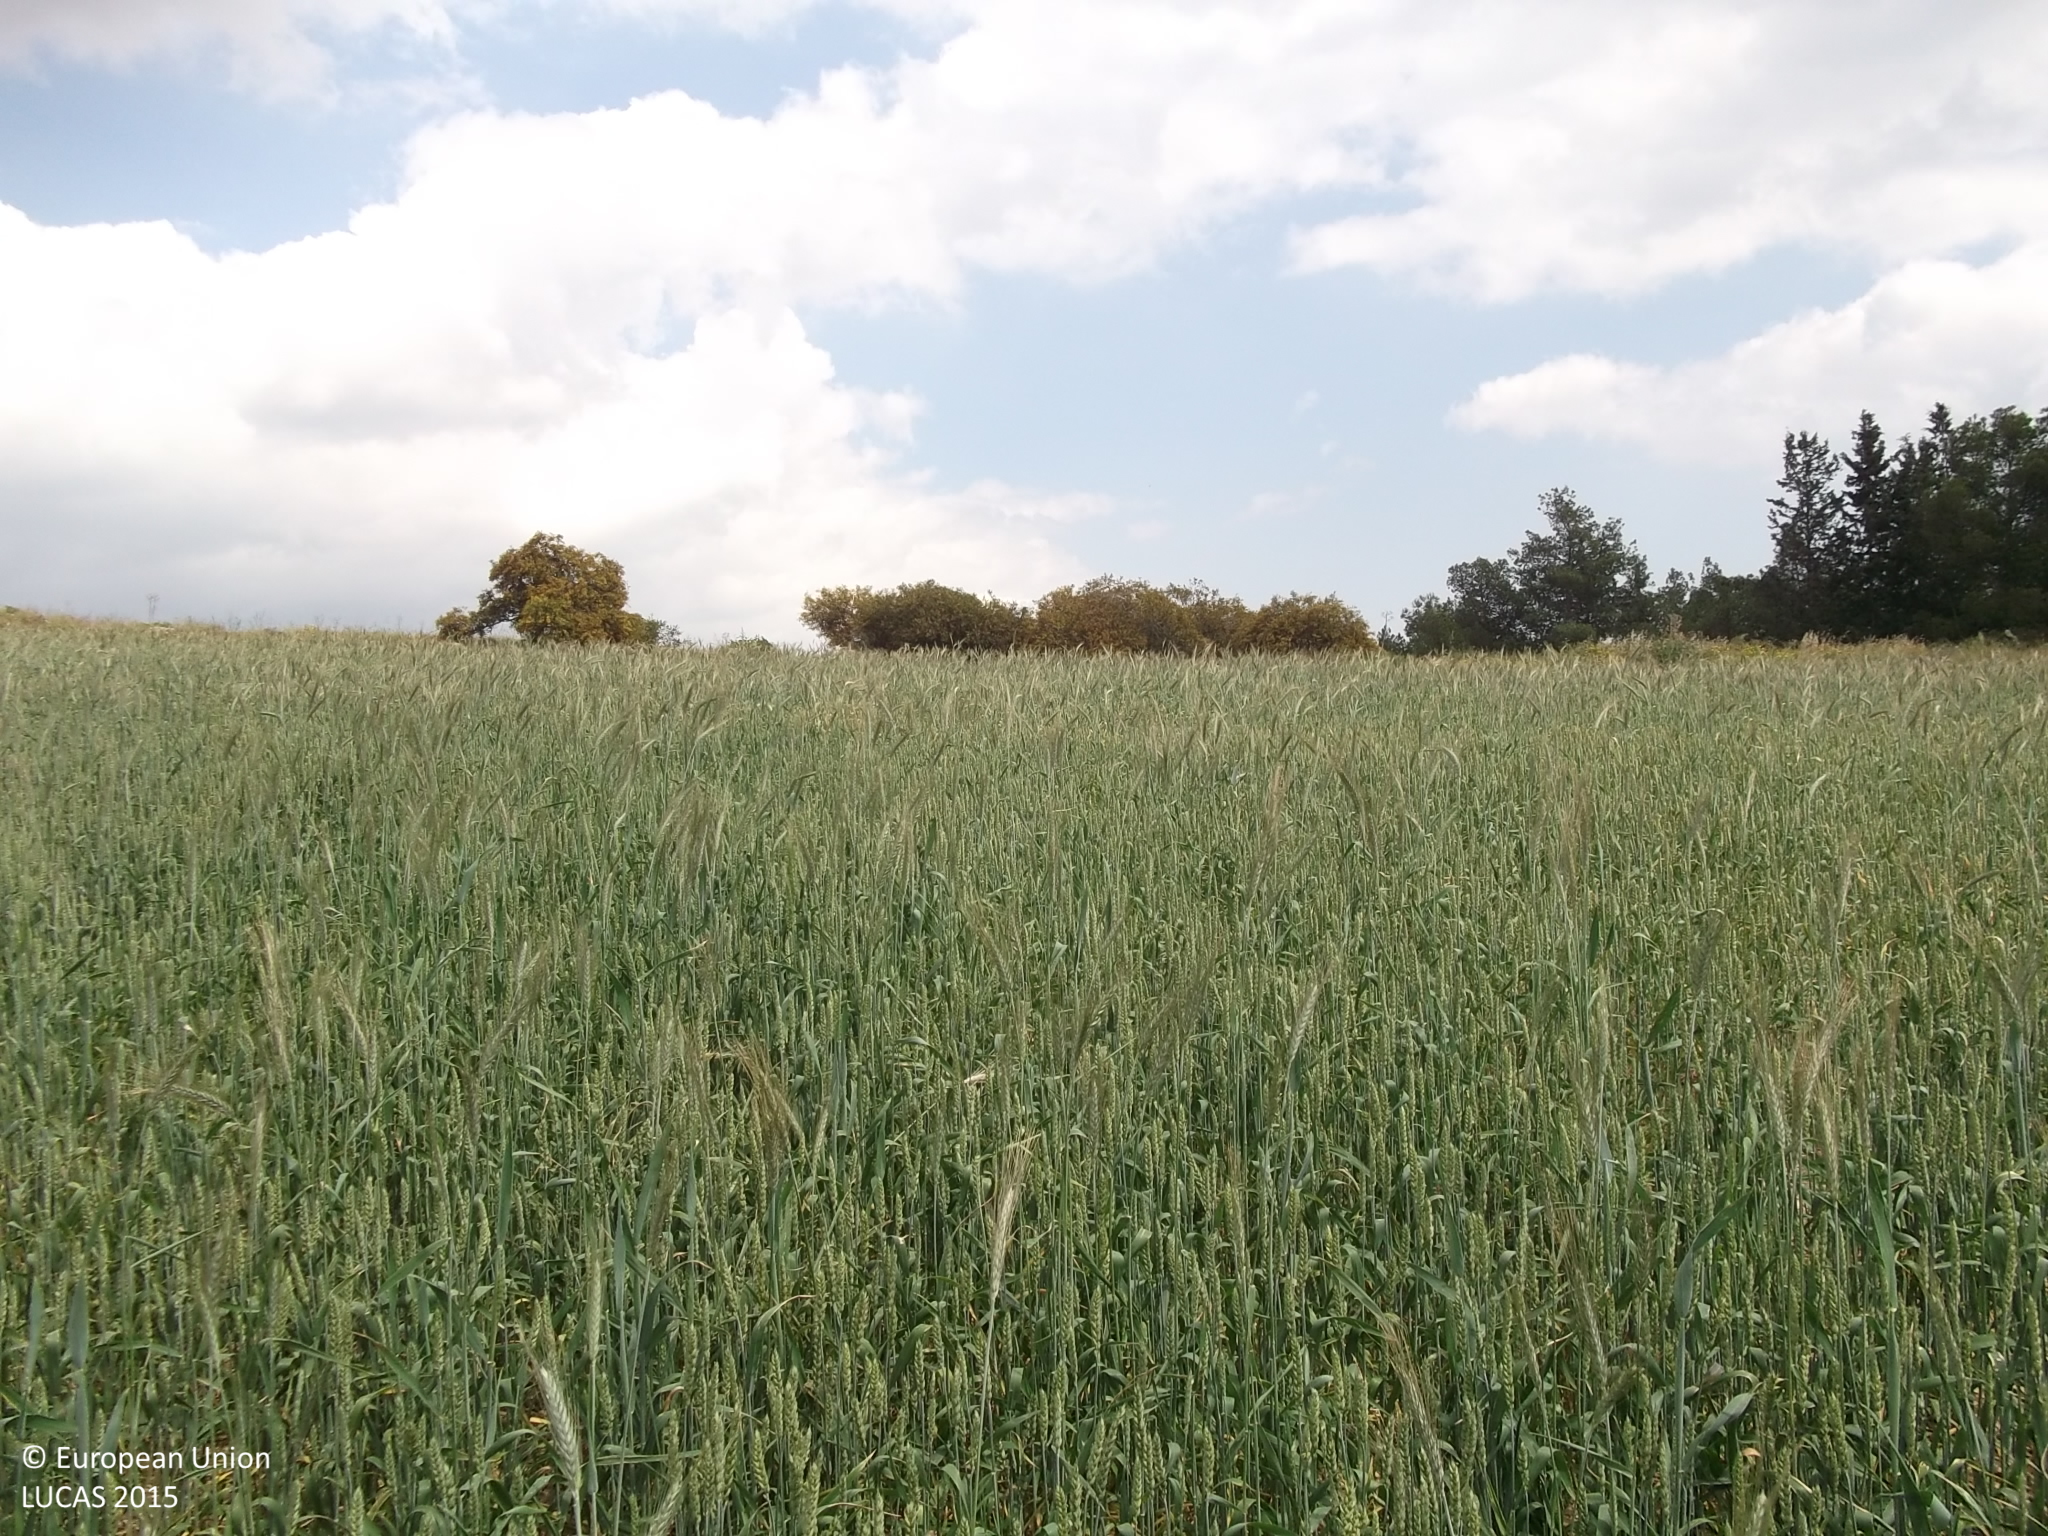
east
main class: Cropland
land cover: Common wheat
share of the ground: > 75 %
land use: Agriculture (excluding fallow land and kitchen gardens)
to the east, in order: Common wheat; Shrubland with sparse tree cover; Fences; Nuts trees; Fences; Spontaneously vegetated surfaces; Tracks; Spontaneously vegetated surfaces; Common wheat; Single bushes/trees; Common wheat
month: April
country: CY
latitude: 35.0103
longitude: 33.6853
